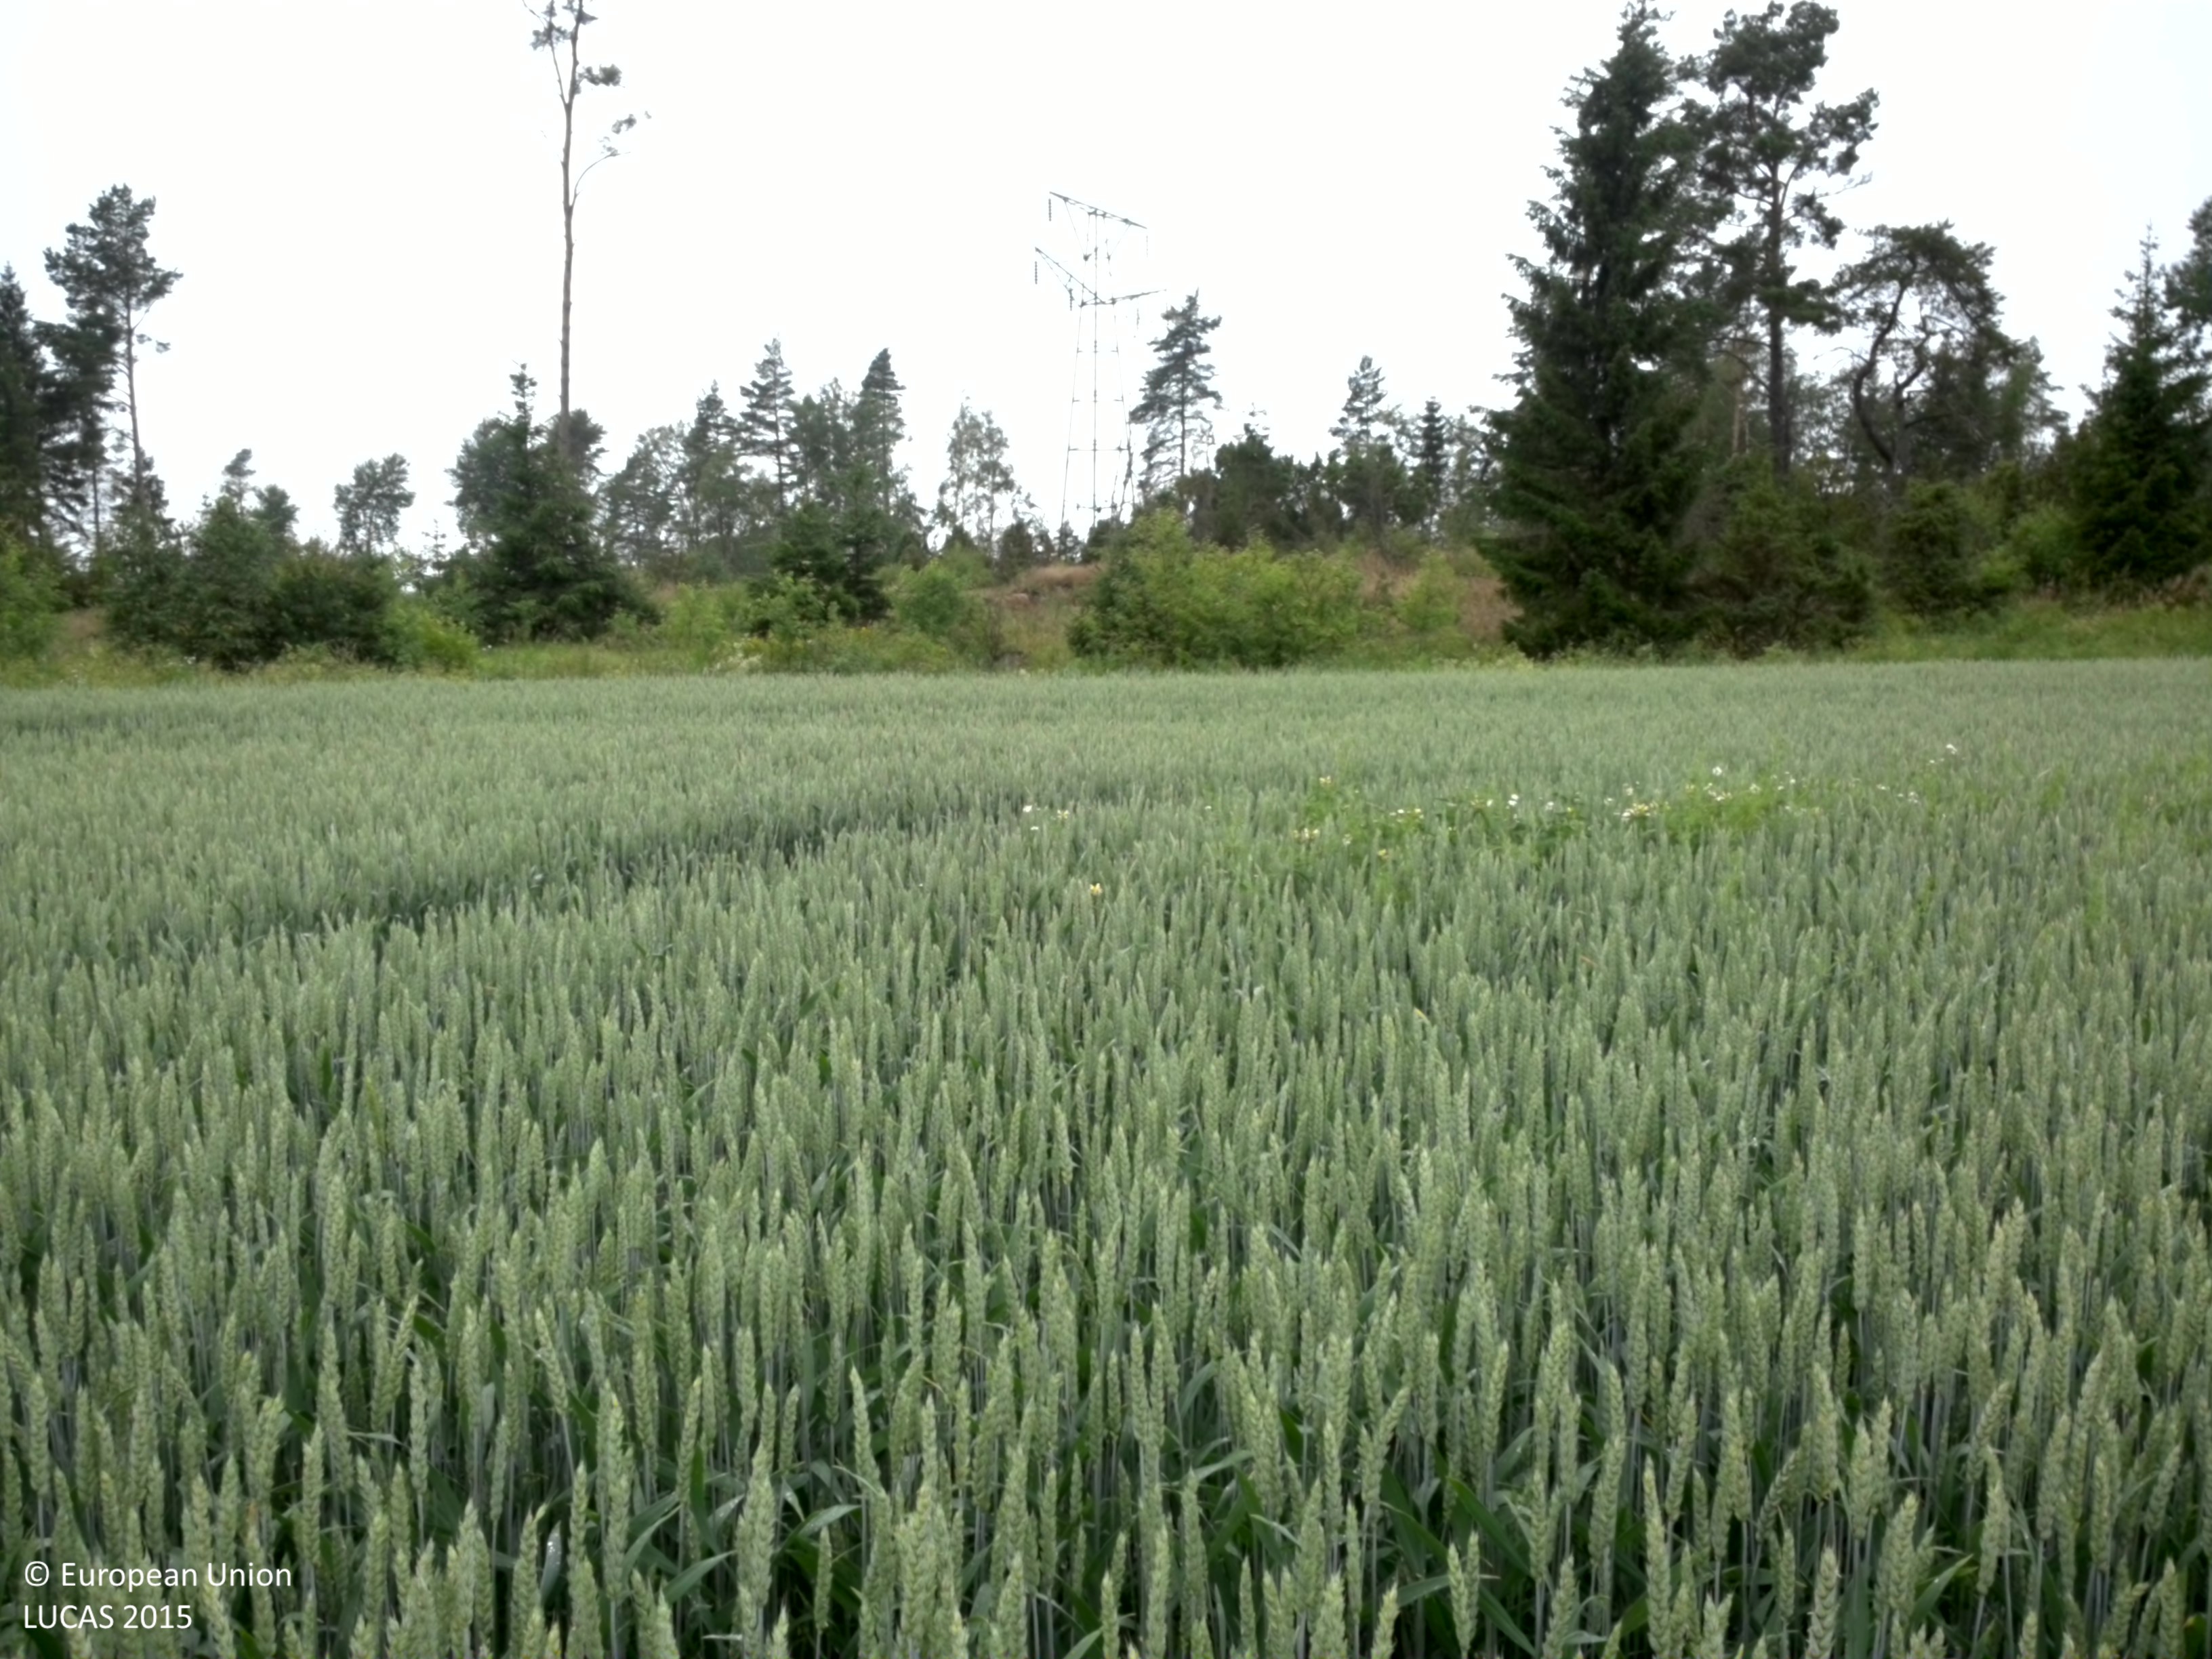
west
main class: Cropland
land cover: Common wheat
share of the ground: > 75 %
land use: Agriculture (excluding fallow land and kitchen gardens)
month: July
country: SE
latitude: 59.8520
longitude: 17.5448
